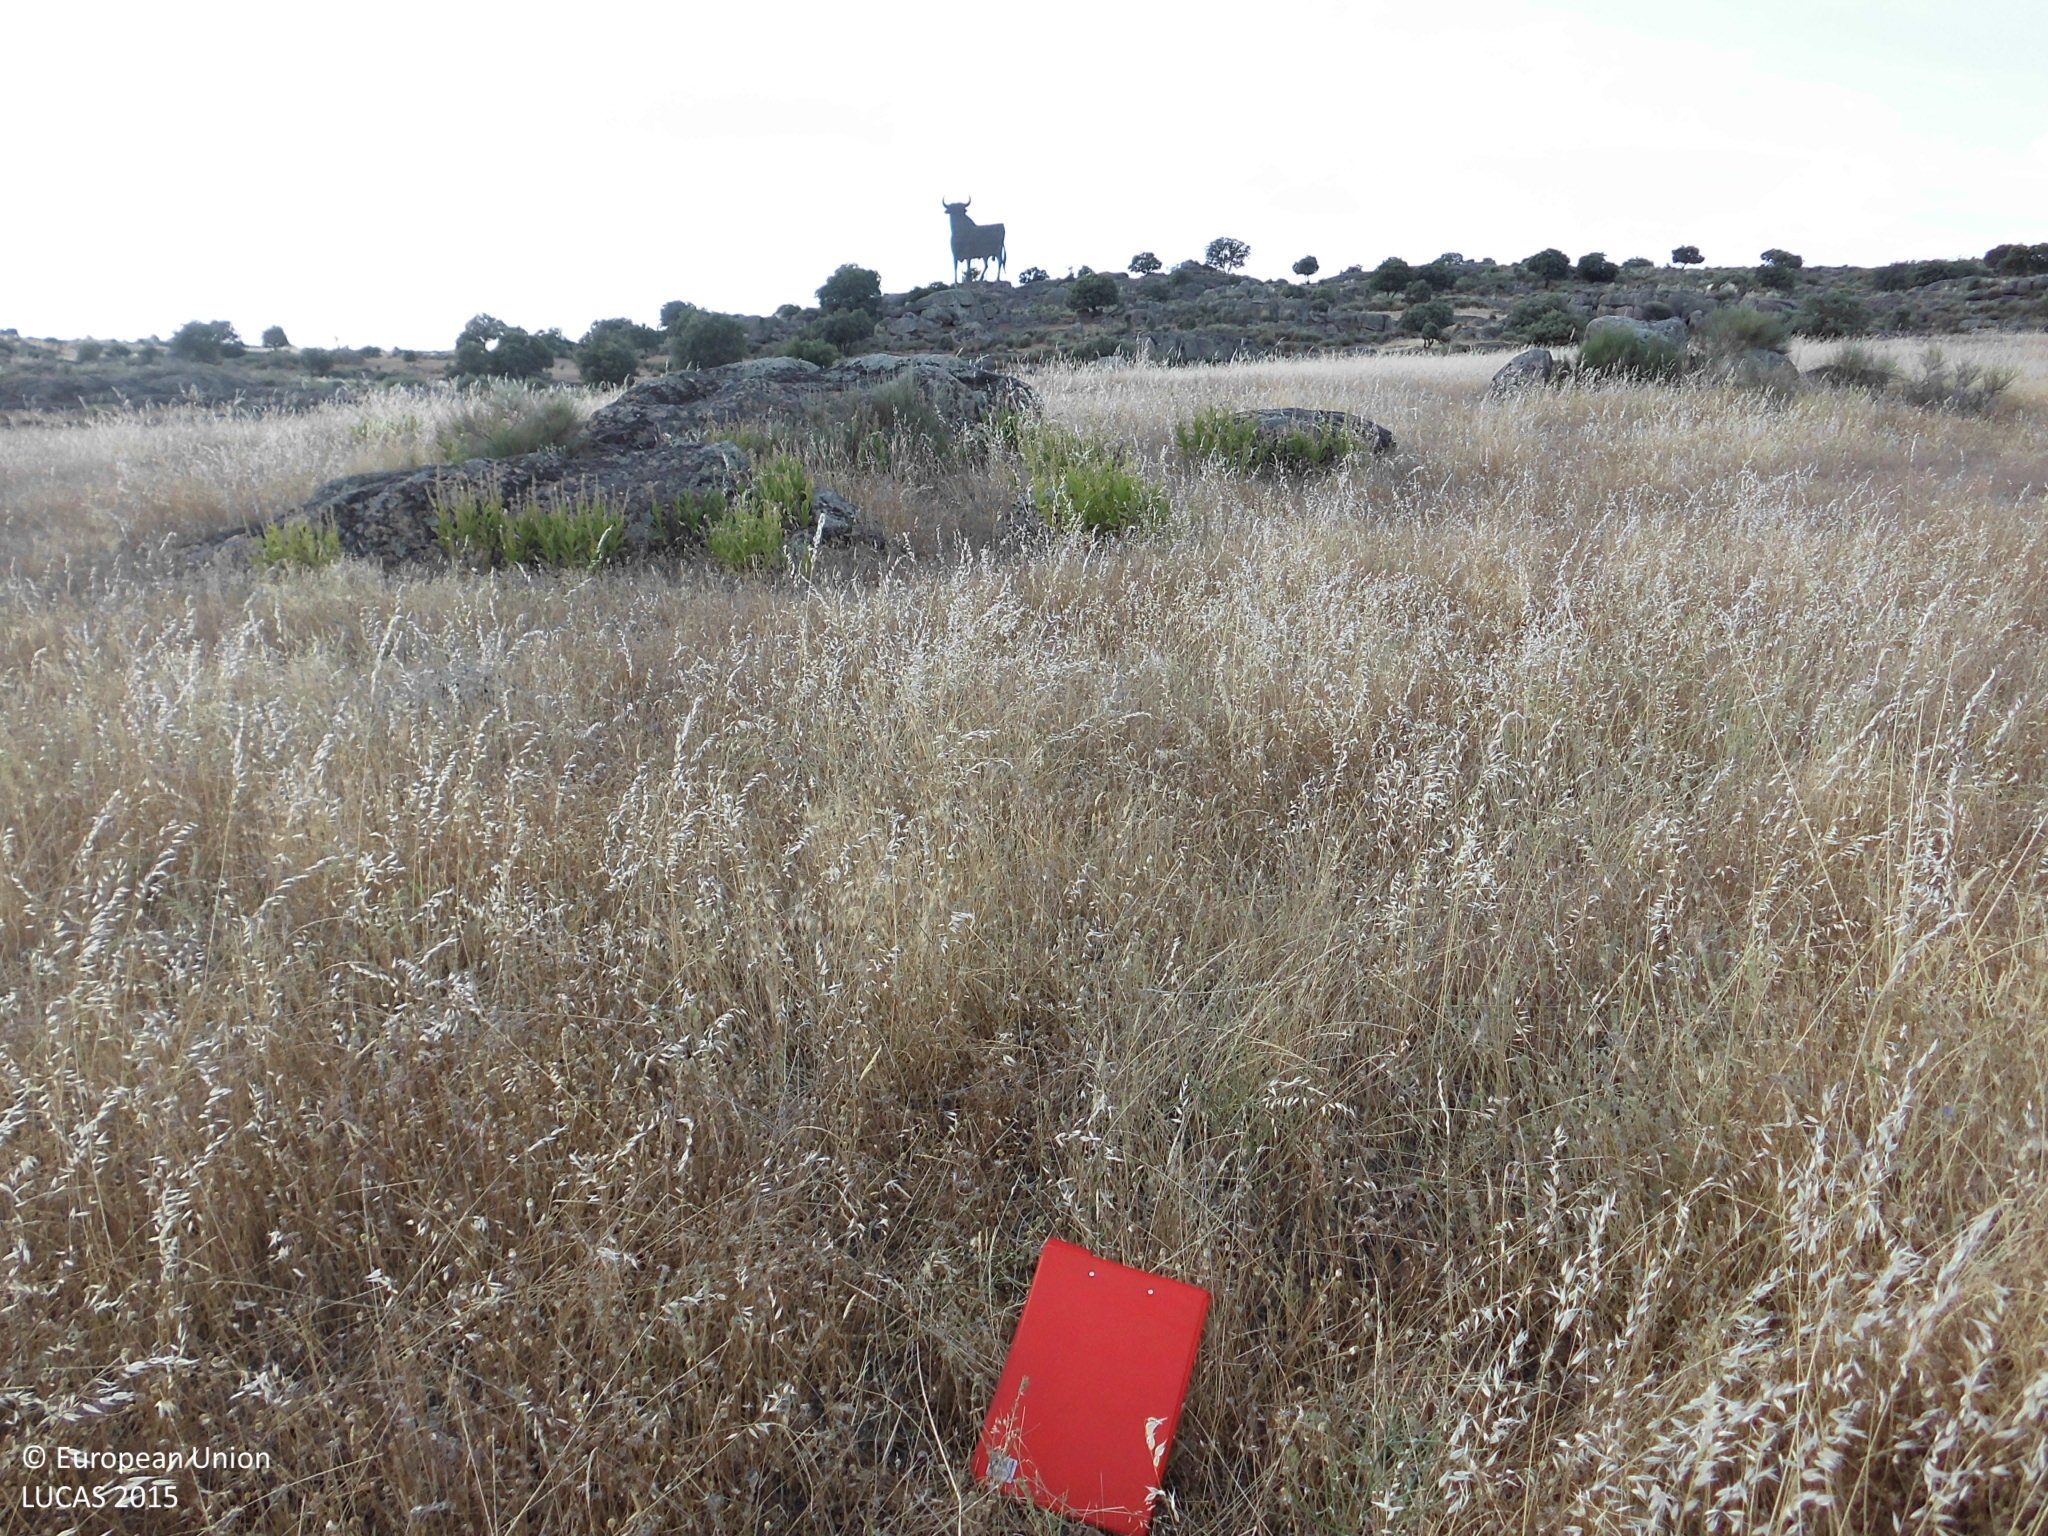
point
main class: Grassland
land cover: Grassland without tree/shrub cover
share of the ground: > 75 %
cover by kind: herbaceous plants 95 %, shrubs 5 %
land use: Agriculture (excluding fallow land and kitchen gardens)
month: June
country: ES
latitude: 39.4229
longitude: -5.8905
